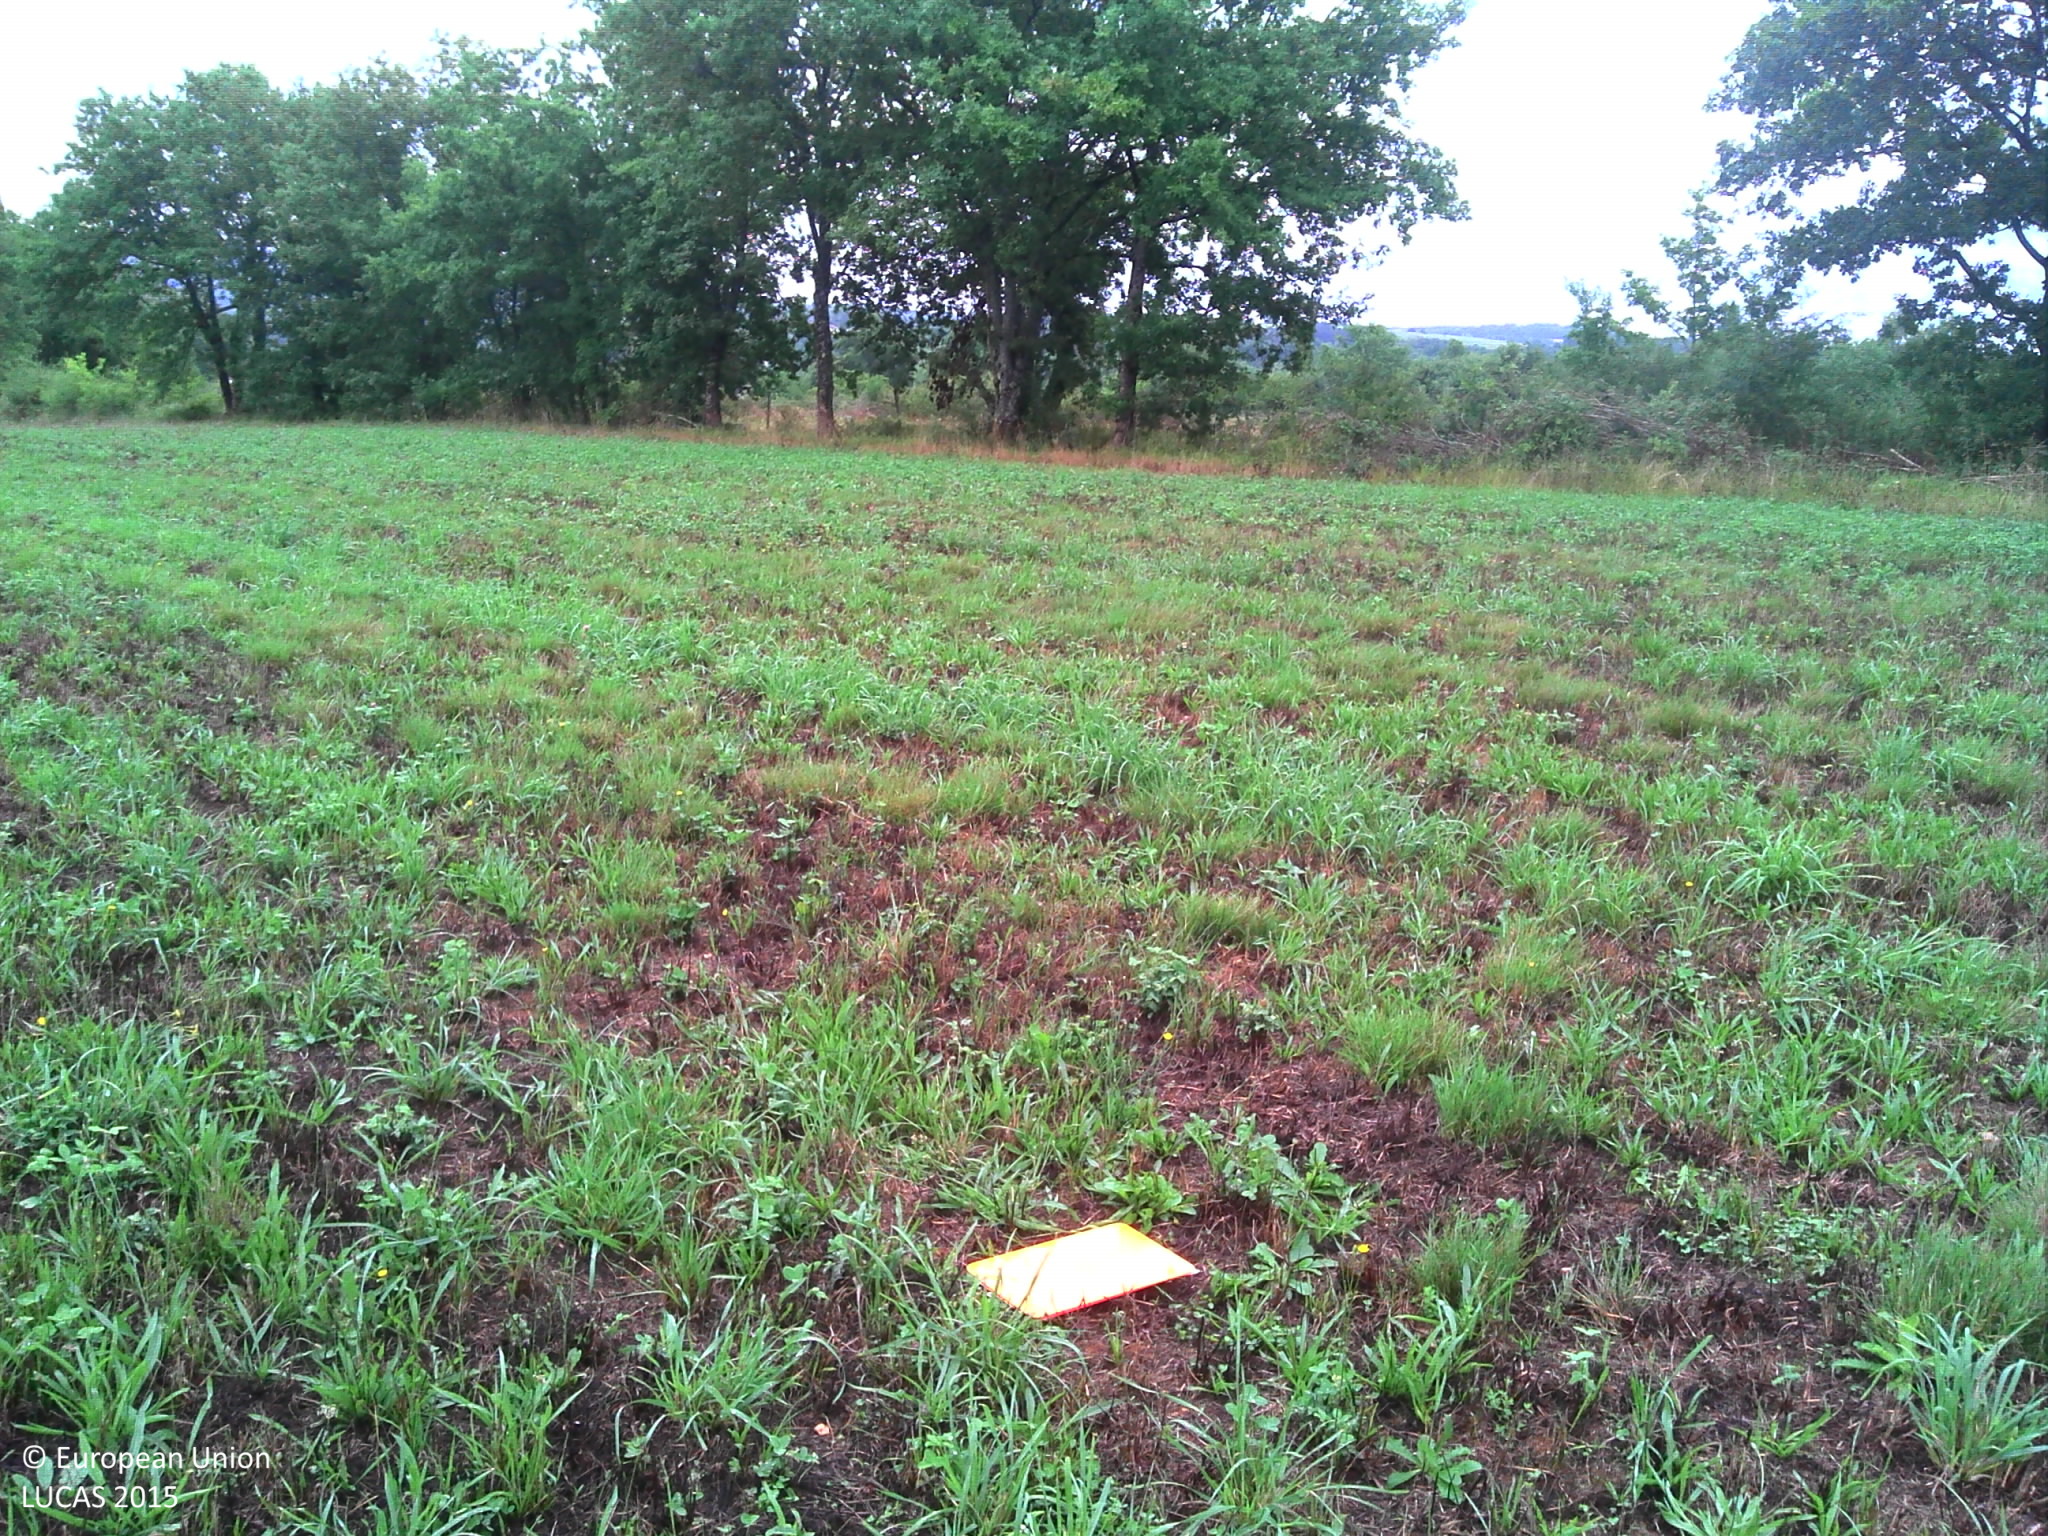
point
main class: Cropland
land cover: Temporary grasslands
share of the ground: 50 - 75 %
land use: Agriculture (excluding fallow land and kitchen gardens)
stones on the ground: < 10 %
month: August
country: FR
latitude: 45.4953
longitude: 0.7369
